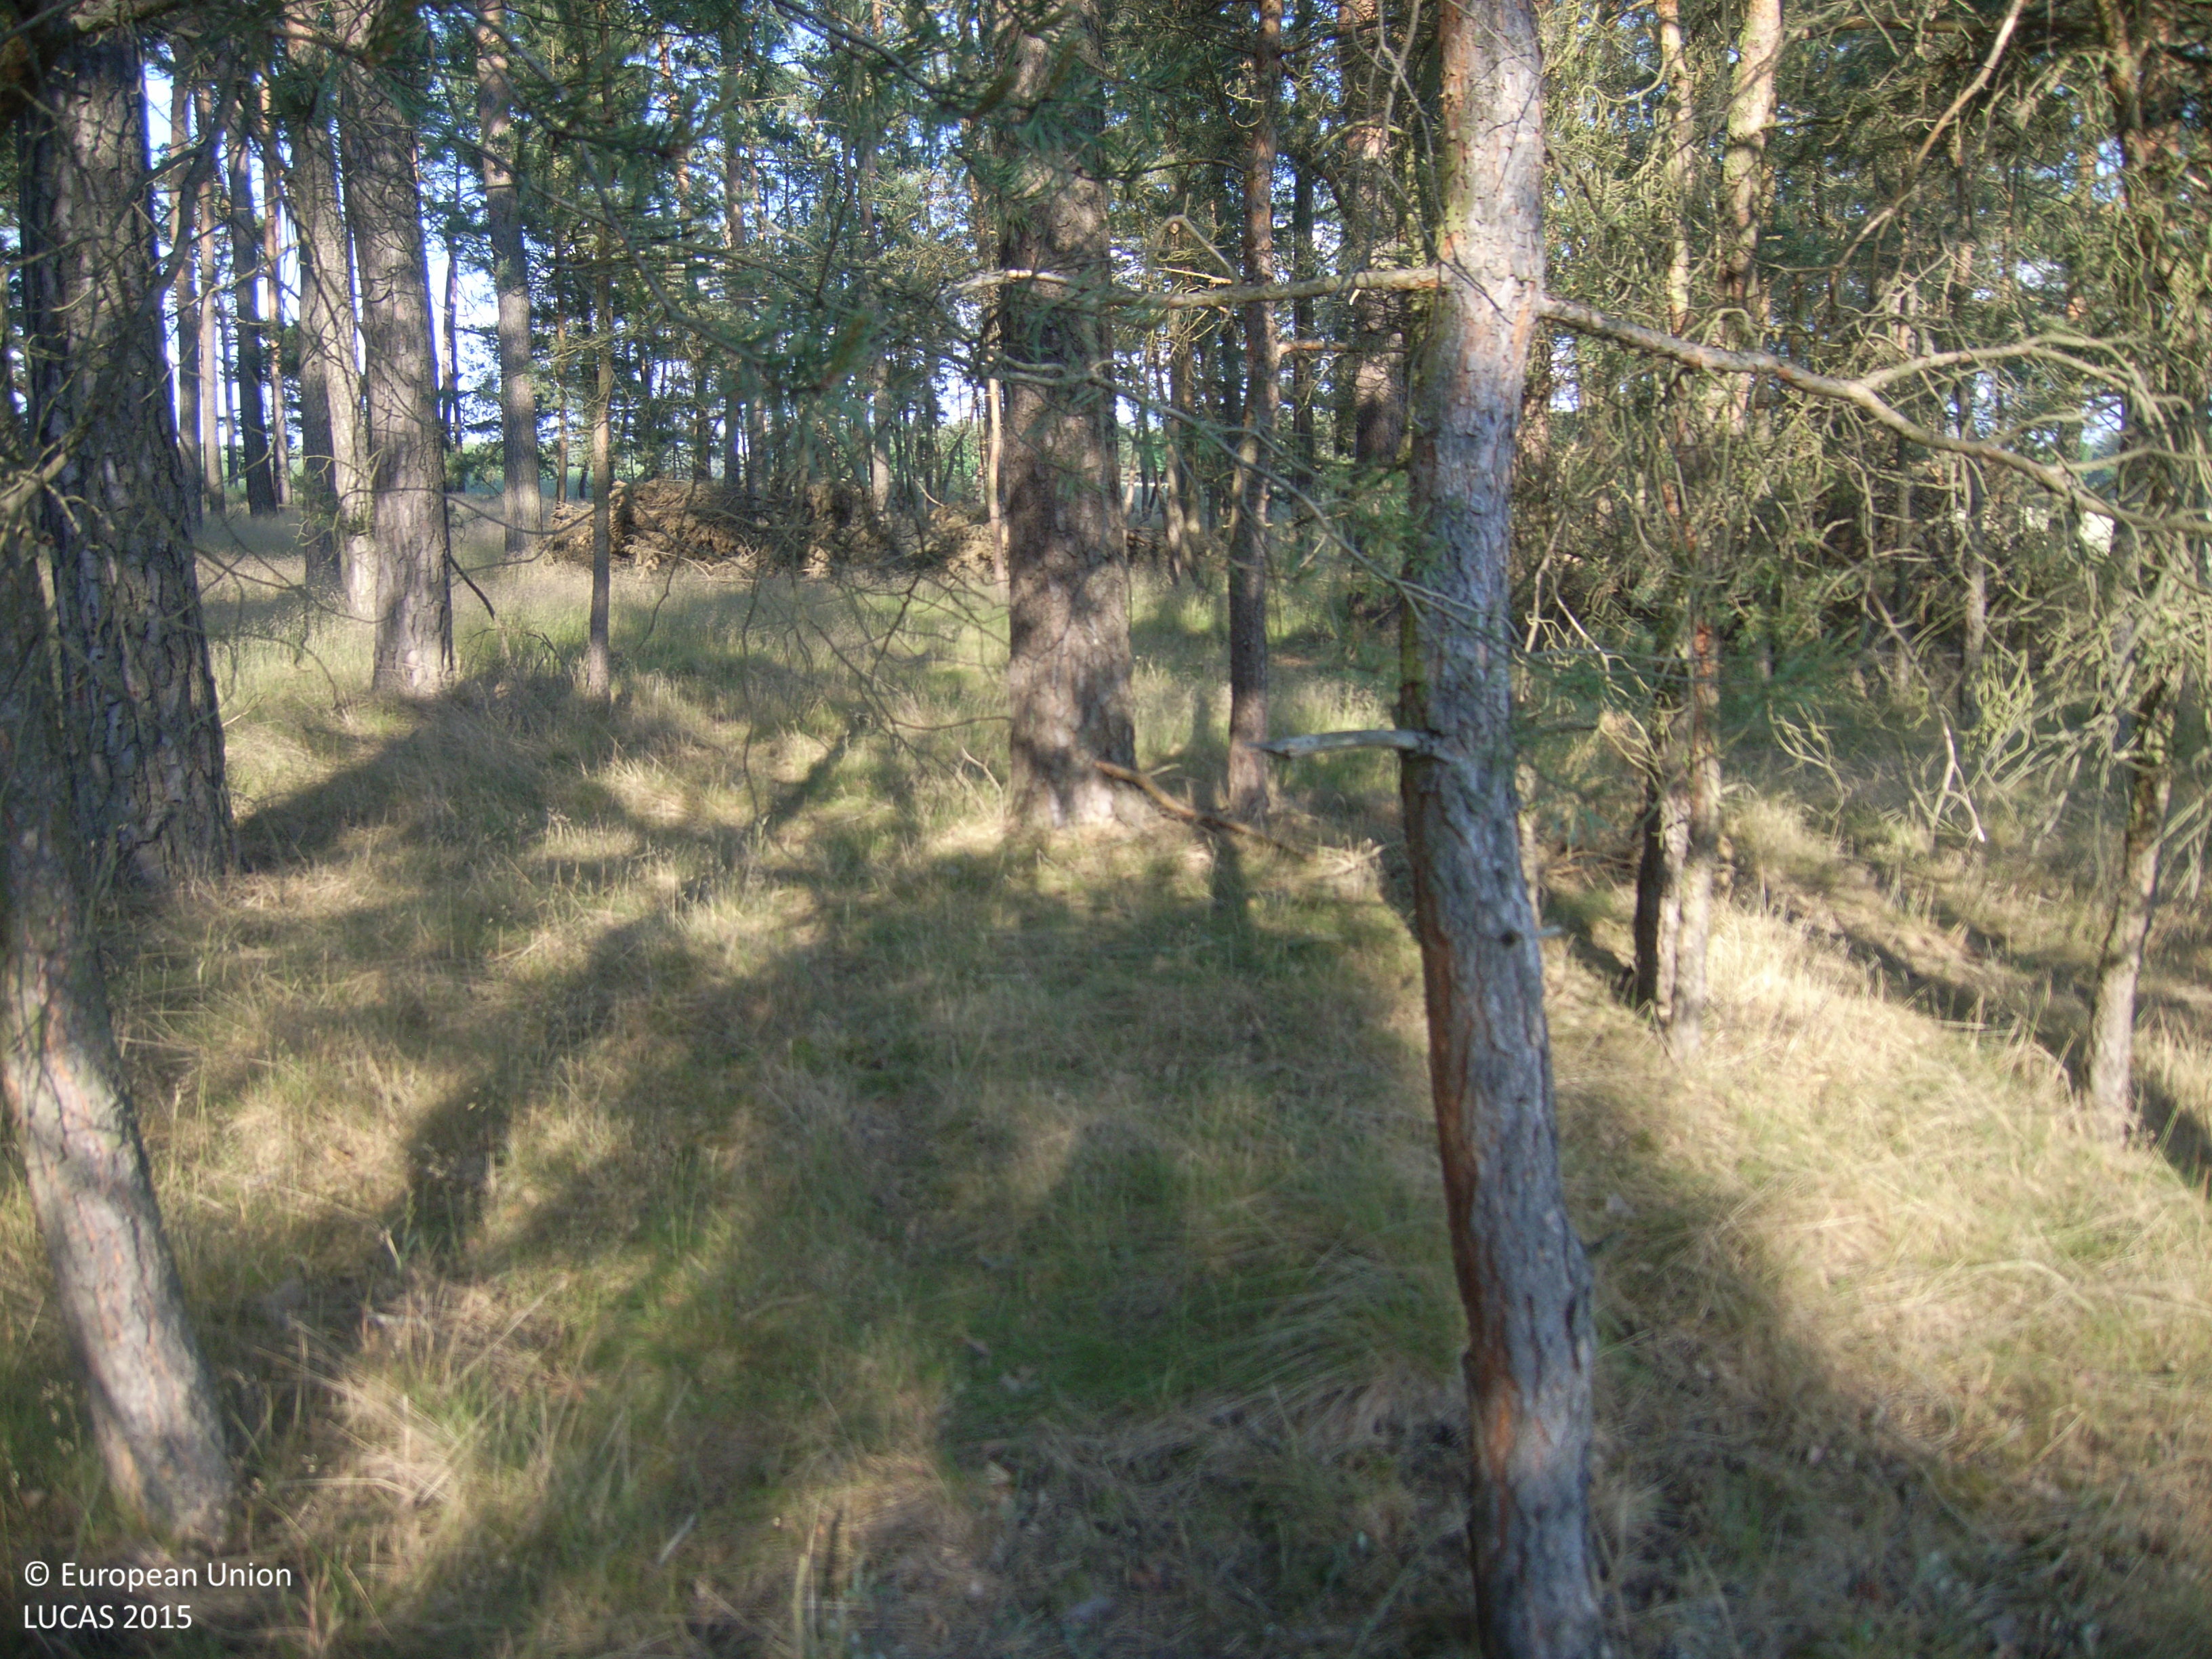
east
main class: Woodland
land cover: Pine dominated coniferous woodland
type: hemiboreal forest and nemoral coniferous forest and mixed broadleaved-coniferous forest
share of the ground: > 75 %
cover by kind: coniferous forest trees 100 %
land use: Forestry
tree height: > 5 m
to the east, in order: Pine dominated coniferous woodland; Rye
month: June
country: DE
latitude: 52.0368
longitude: 14.0974
